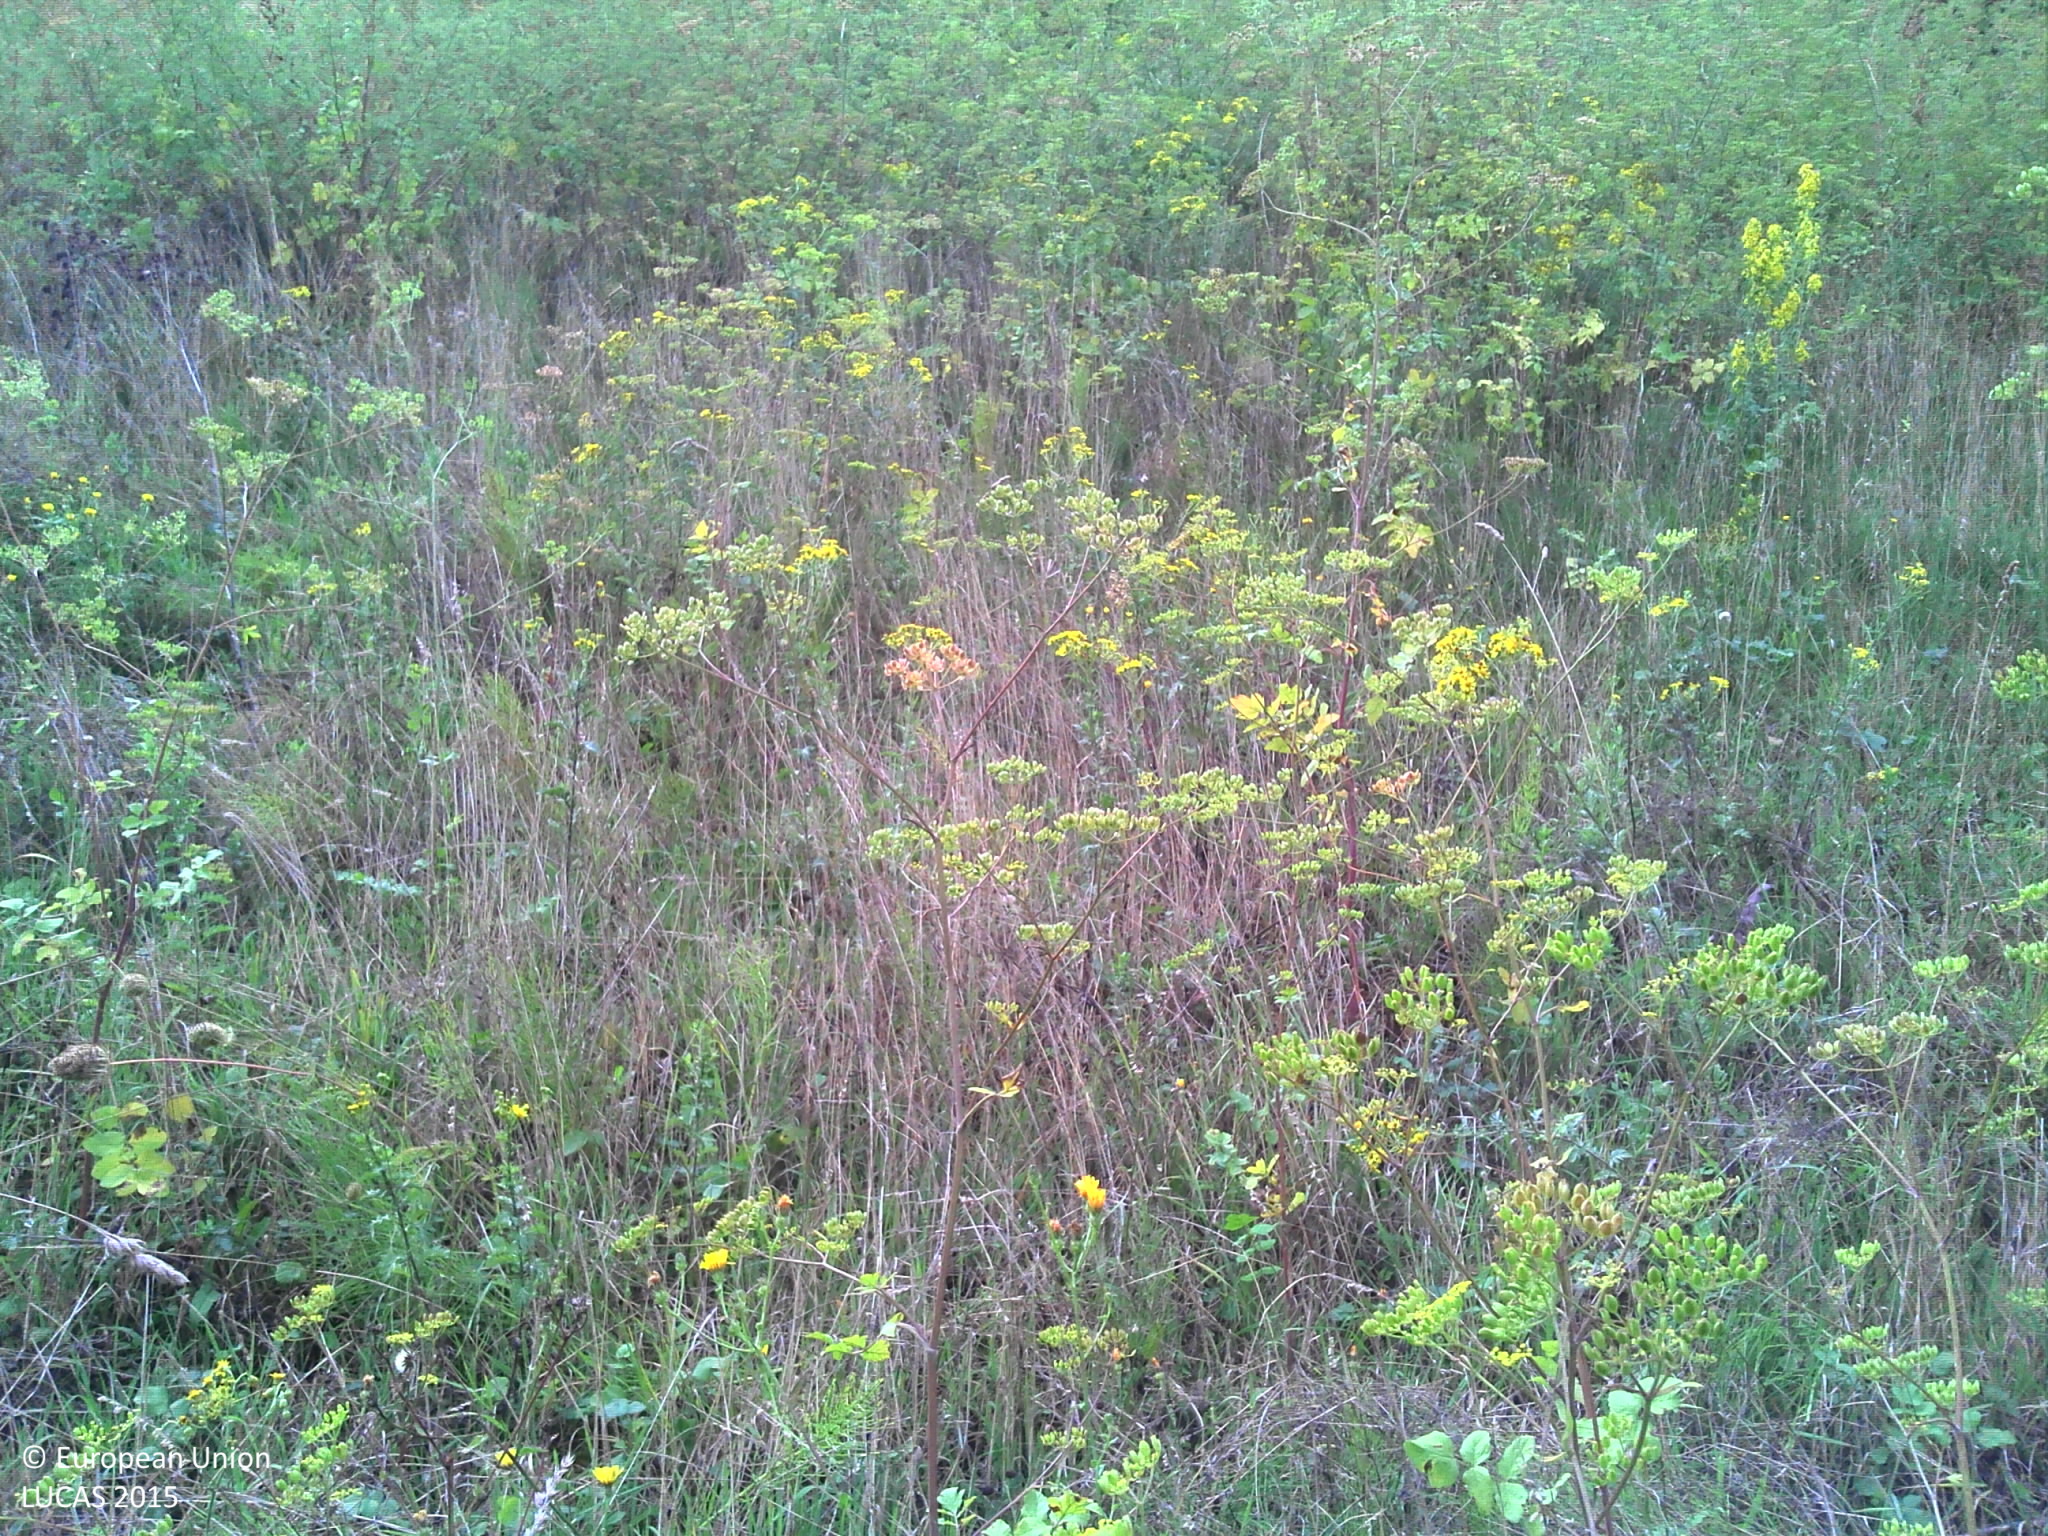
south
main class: Grassland
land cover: Spontaneously vegetated surfaces
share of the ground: > 75 %
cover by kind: herbaceous plants 95 %, shrubs 5 %
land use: Semi-natural and natural areas not in use
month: September
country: FR
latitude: 48.5513
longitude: 6.1120
